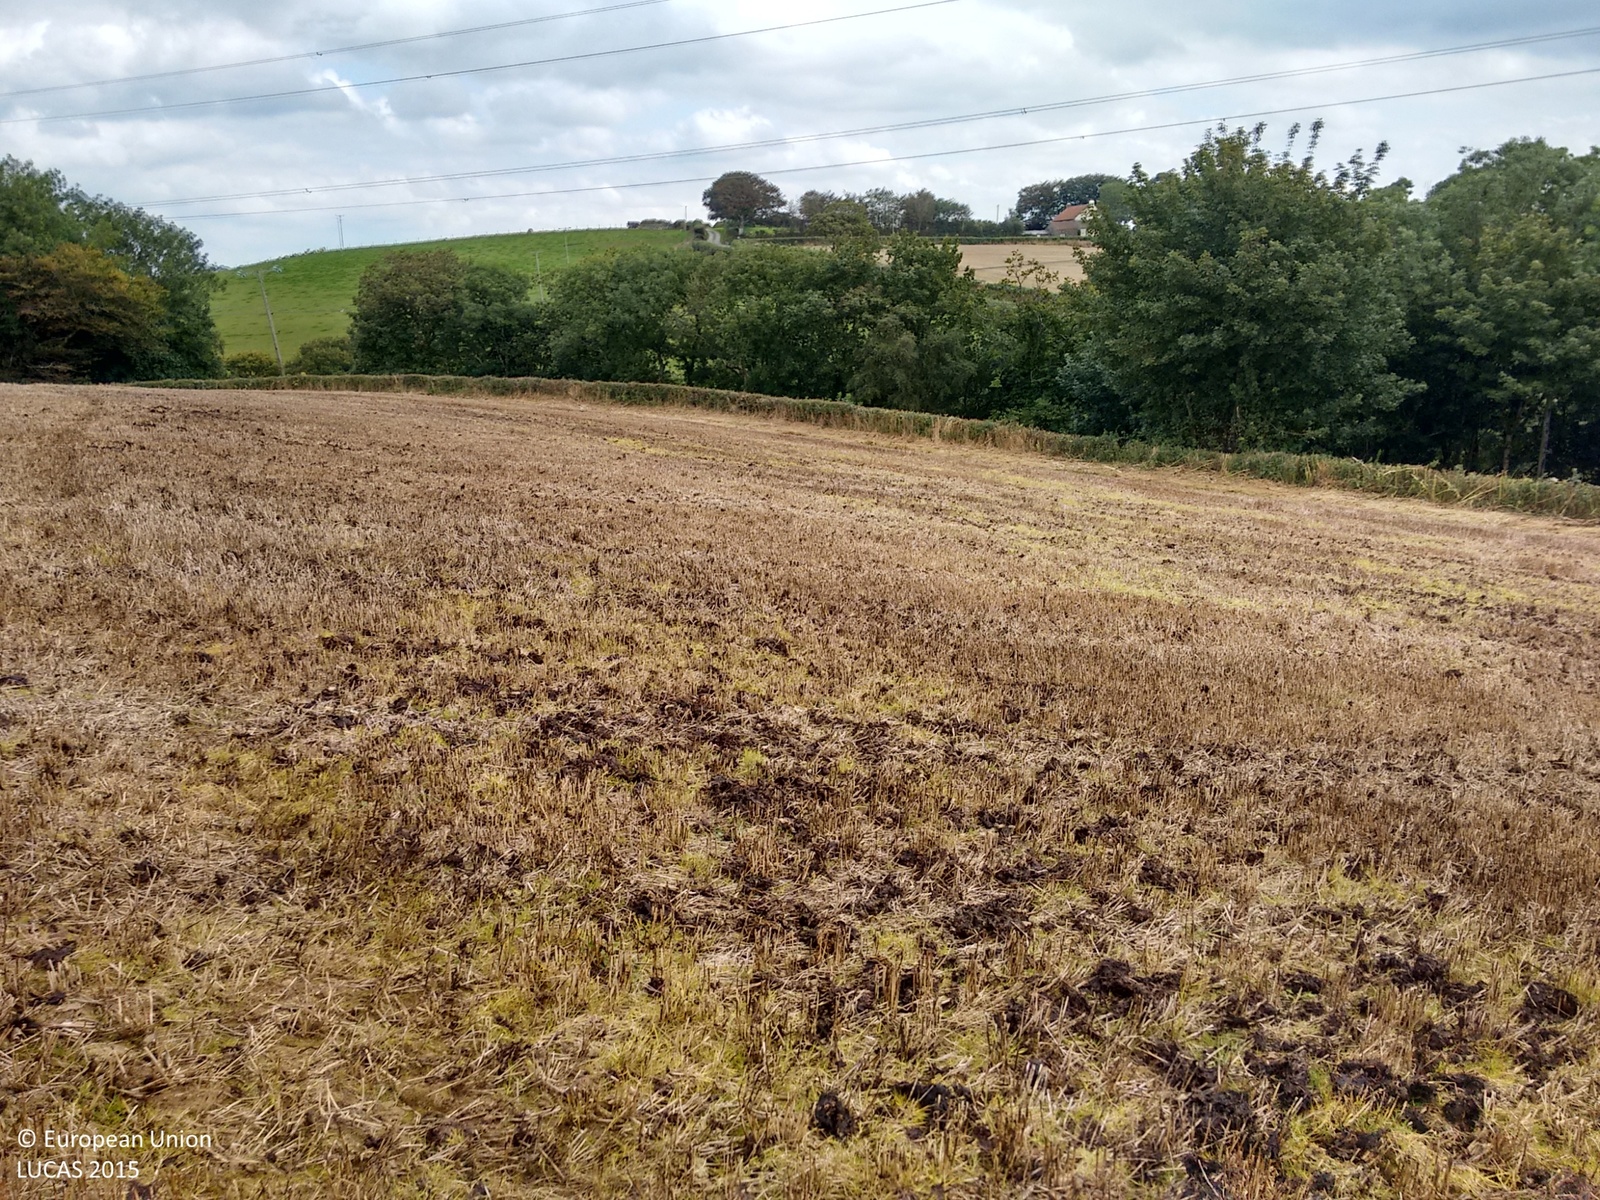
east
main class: Cropland
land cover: Barley
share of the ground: 50 - 75 %
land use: Agriculture (excluding fallow land and kitchen gardens)
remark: Harvested field
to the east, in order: Barley; Managed hedges; Artificial constructions; Grass margins; Paved roads, cycling and walking lanes; Broadleaved woodland; Electric lines; Rivers and streams; Broadleaved woodland; Grassland without tree/shrub cover
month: September
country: GB
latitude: 50.9054
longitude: -4.2781
